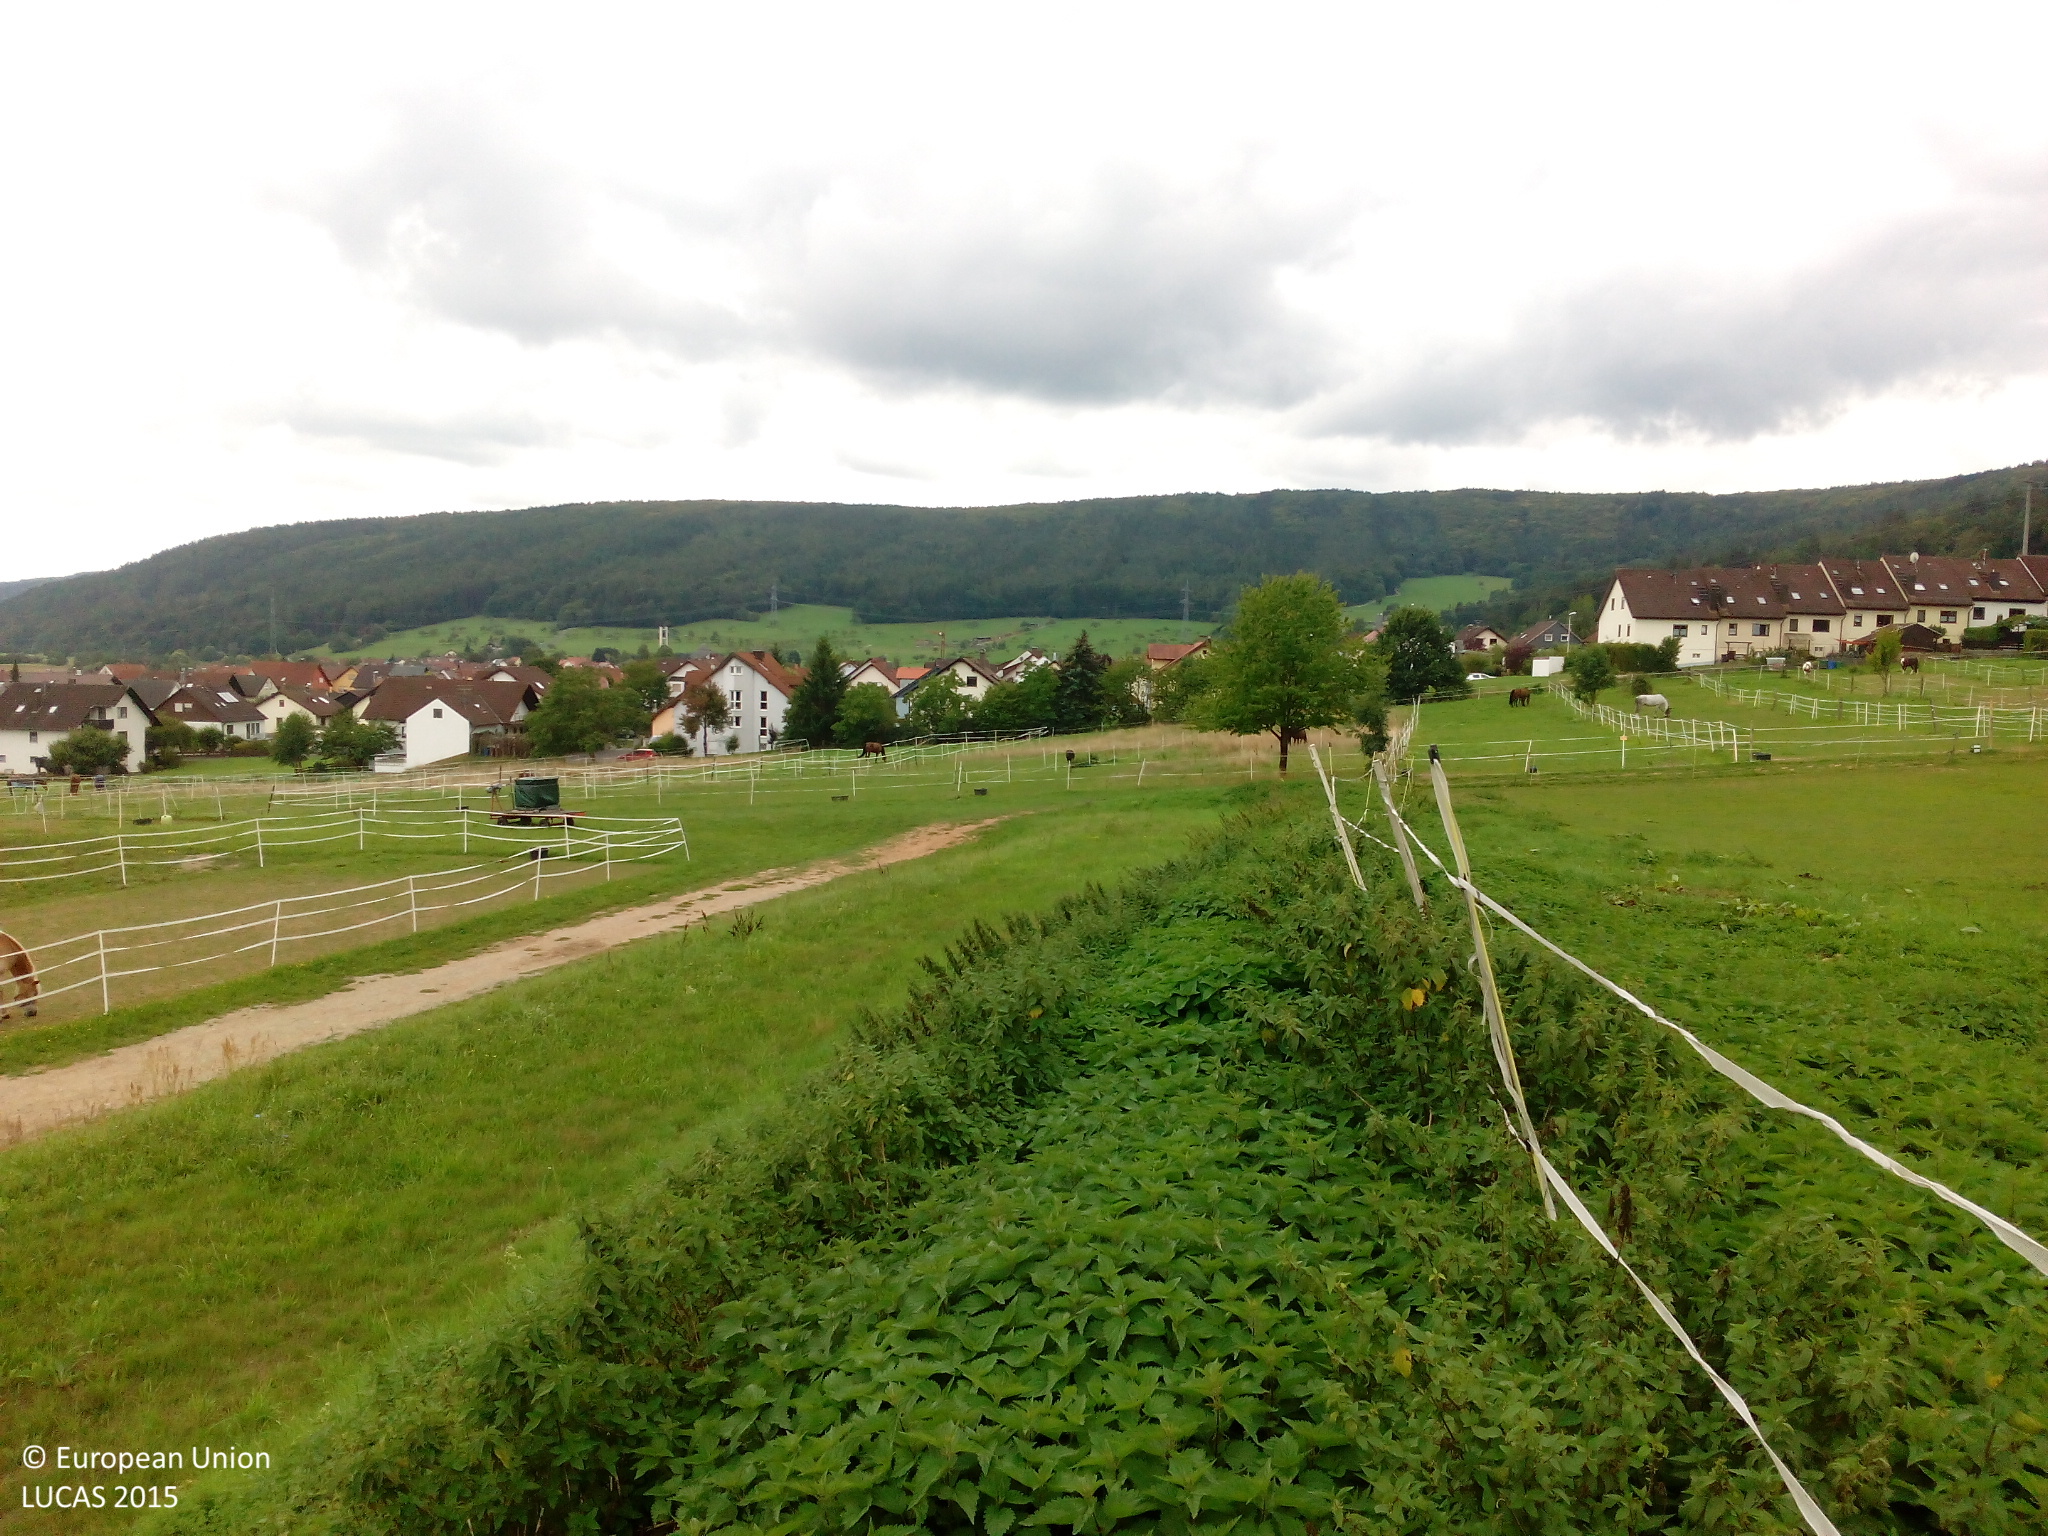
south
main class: Grassland
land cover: Grassland without tree/shrub cover
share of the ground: > 75 %
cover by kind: herbaceous plants 80 %, unconsolidated bare surface 20 %
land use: Agriculture (excluding fallow land and kitchen gardens)
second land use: Amenities, museums, leisure
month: September
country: DE
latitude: 49.9856
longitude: 9.5678
